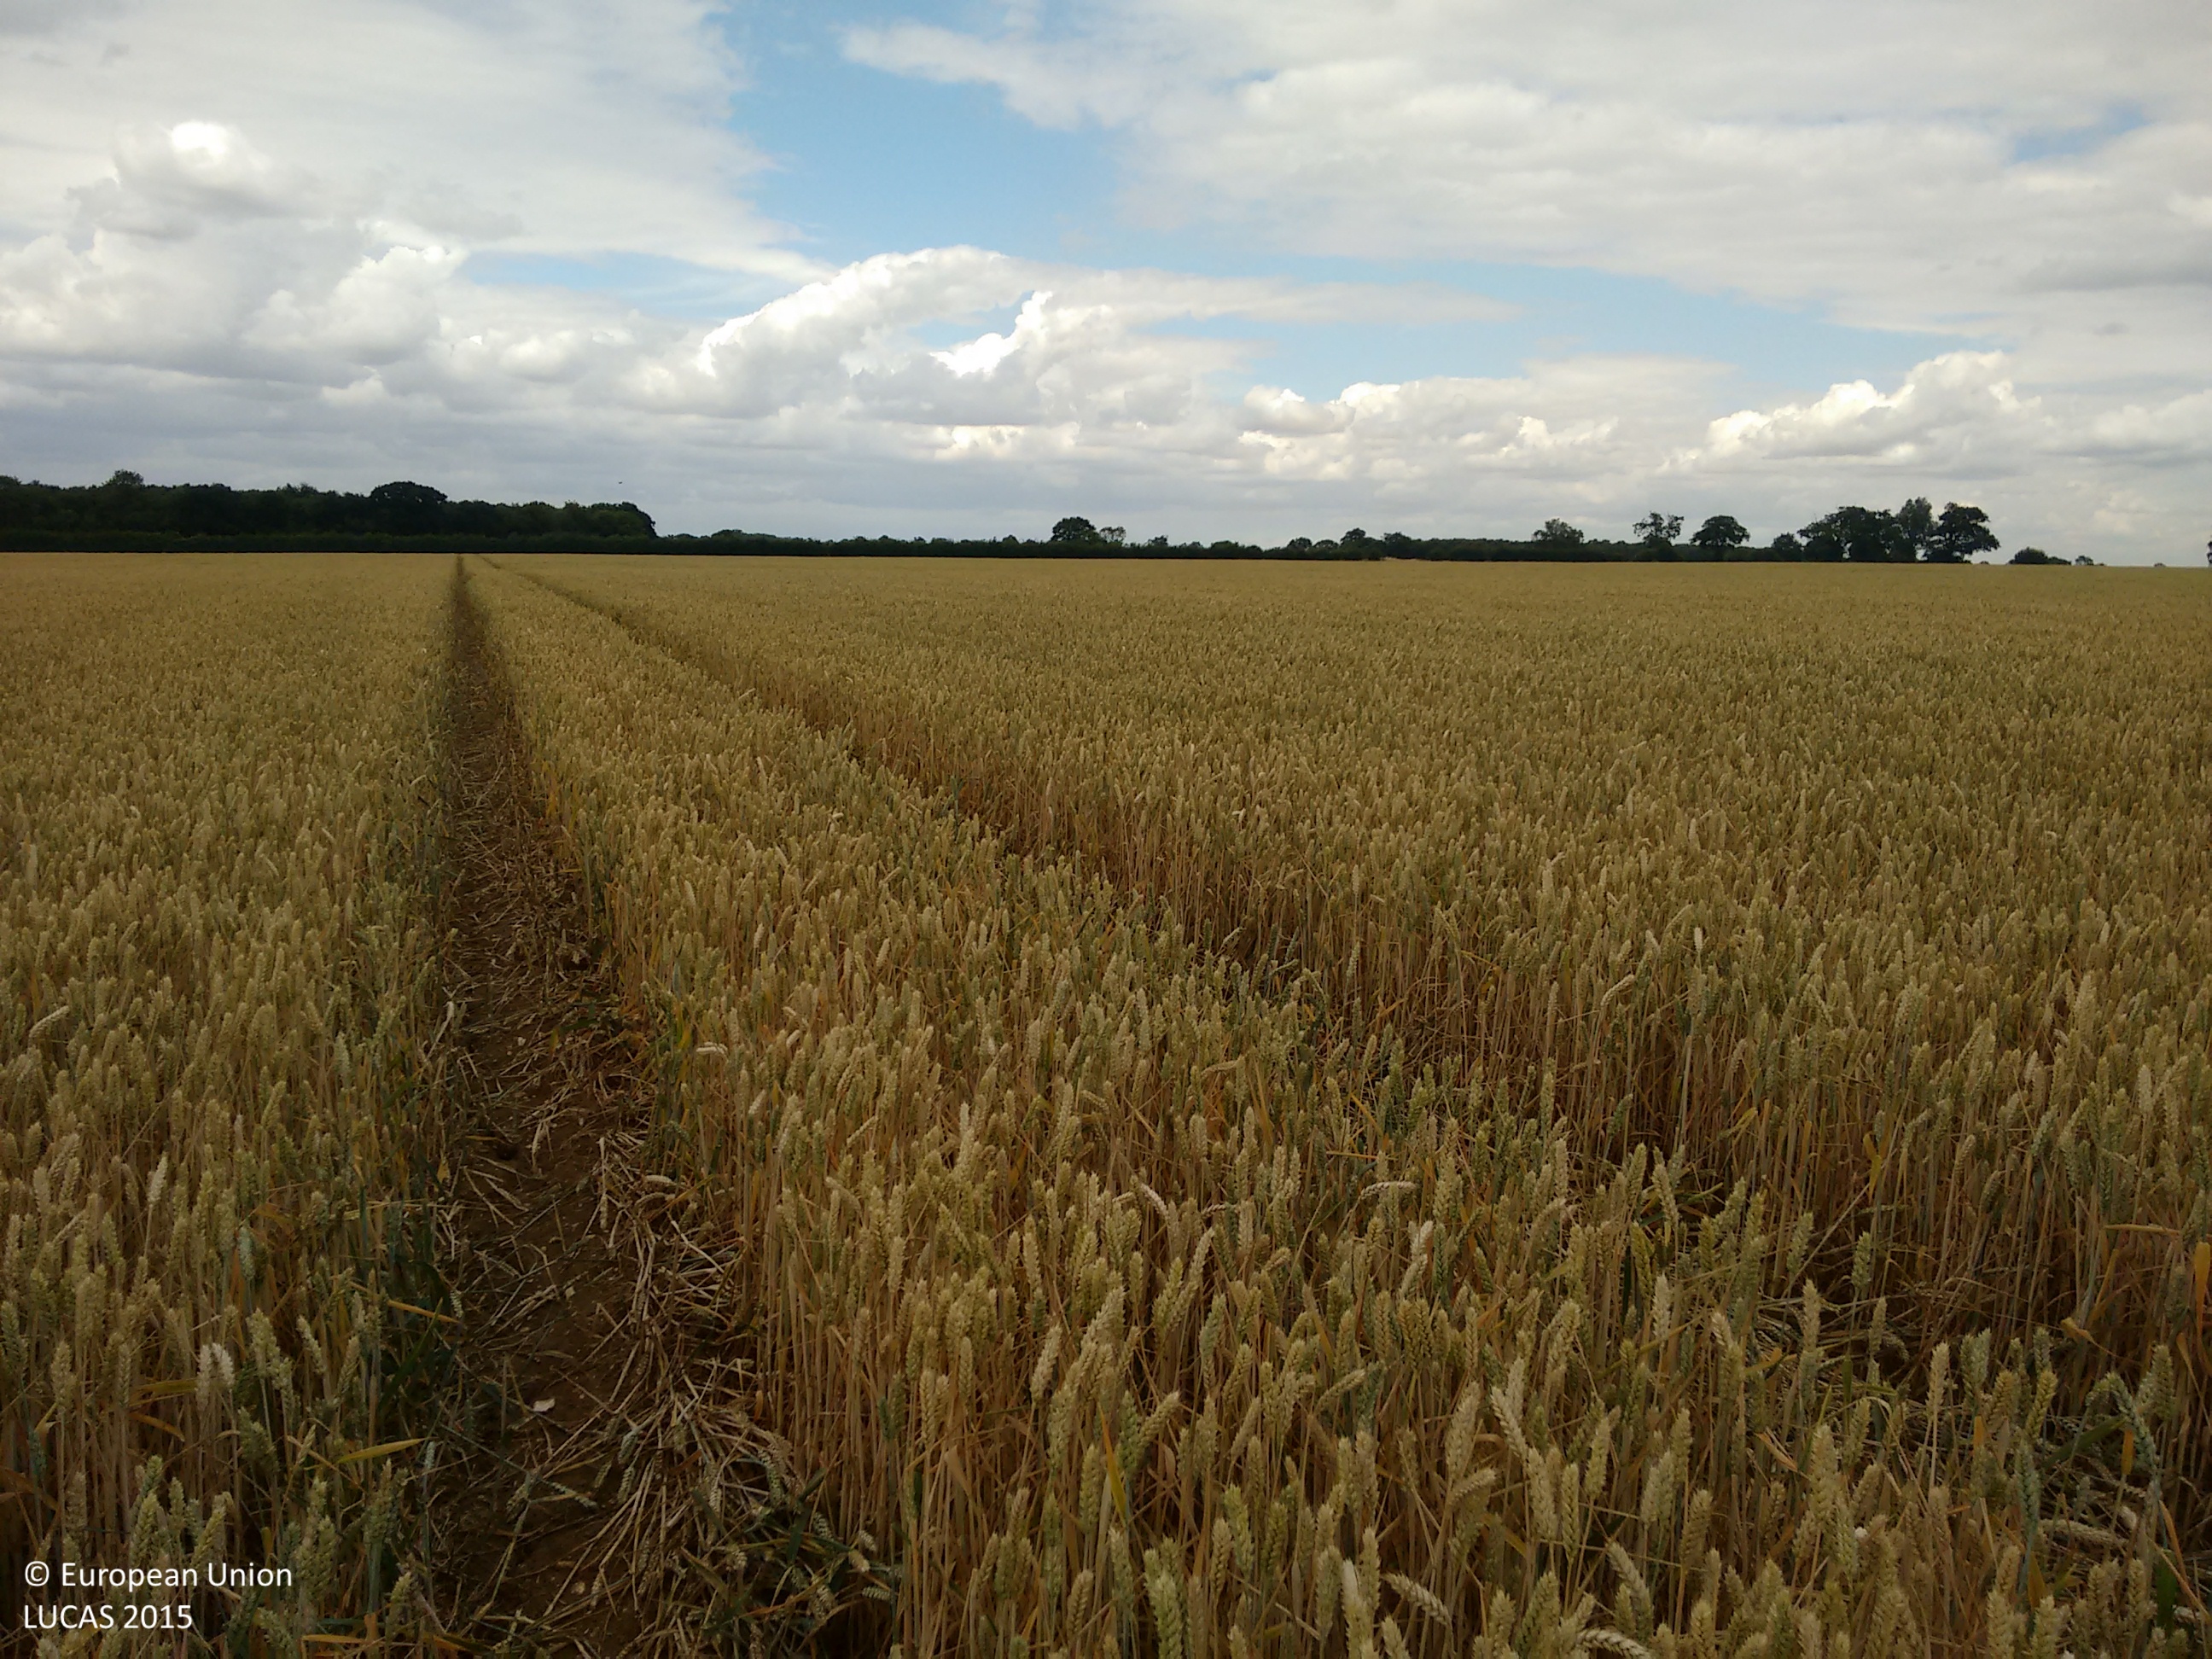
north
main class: Cropland
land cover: Common wheat
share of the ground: > 75 %
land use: Agriculture (excluding fallow land and kitchen gardens)
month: July
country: GB
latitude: 51.8038
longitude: 0.5900
